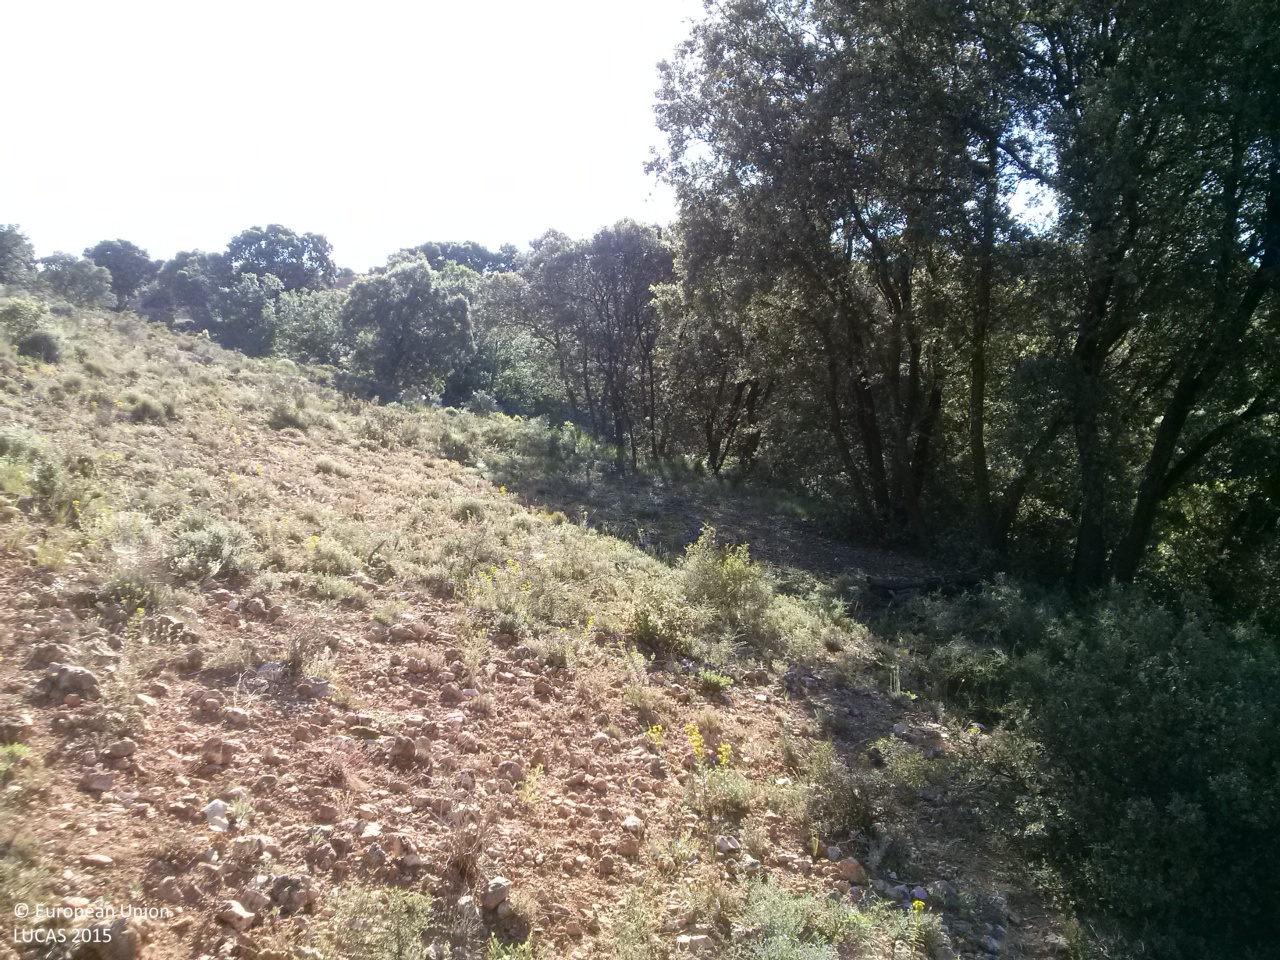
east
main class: Woodland
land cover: Broadleaved woodland
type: broadleaved evergreen forest
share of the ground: 10 - 25 %
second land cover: Shrubland without tree cover
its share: 25 - 50 %
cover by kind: shrubs 30 %, broadleaved forest trees 25 %, unconsolidated bare surface 25 %, herbaceous plants 20 %
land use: Forestry
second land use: Agriculture (excluding fallow land and kitchen gardens)
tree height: > 5 m
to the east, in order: Broadleaved woodland; Shrubland without tree cover; Barley; Broadleaved woodland; Rock outcrops; Grass margins; Sunflower; Grass margins; Single bushes/trees; Grass margins; Tracks; Grass margins; Abandoned hedges; Grass margins; Sunflower
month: May
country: ES
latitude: 40.3226
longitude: -2.5091
